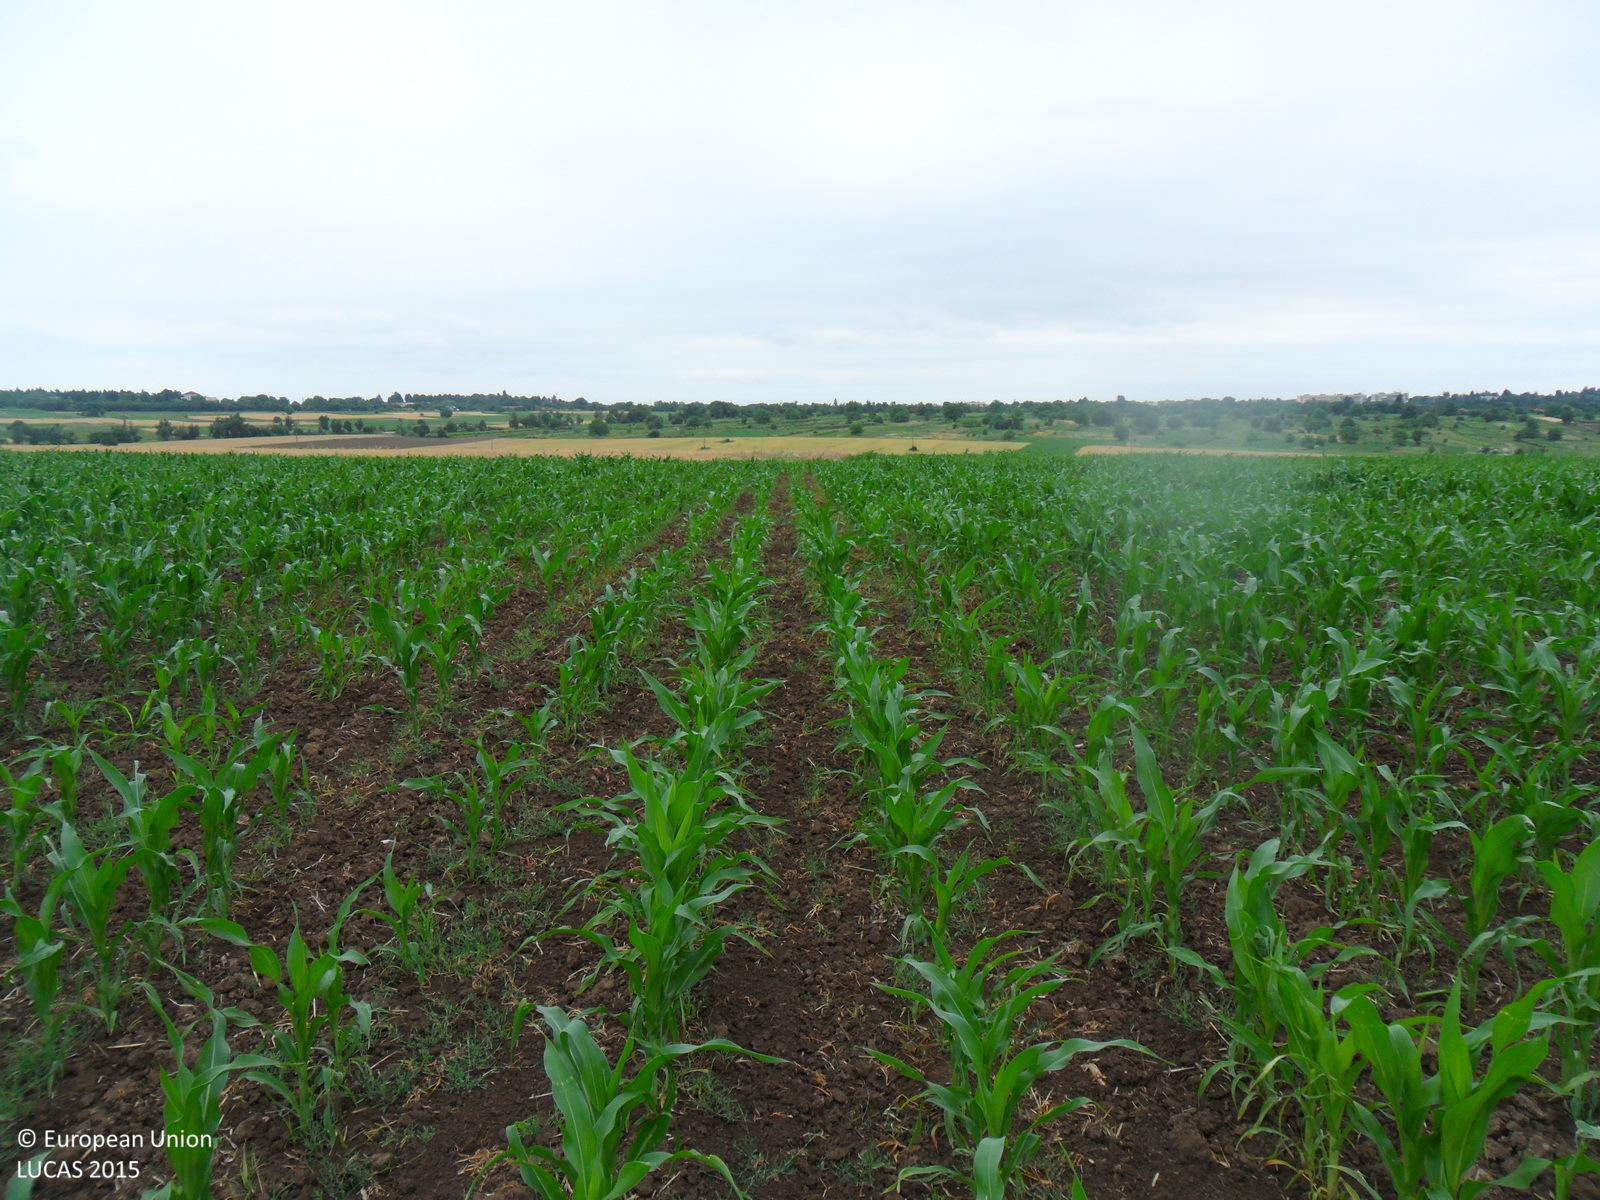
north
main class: Cropland
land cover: Maize
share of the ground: 25 - 50 %
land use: Agriculture (excluding fallow land and kitchen gardens)
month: June
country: BG
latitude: 43.7453
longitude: 26.6646
